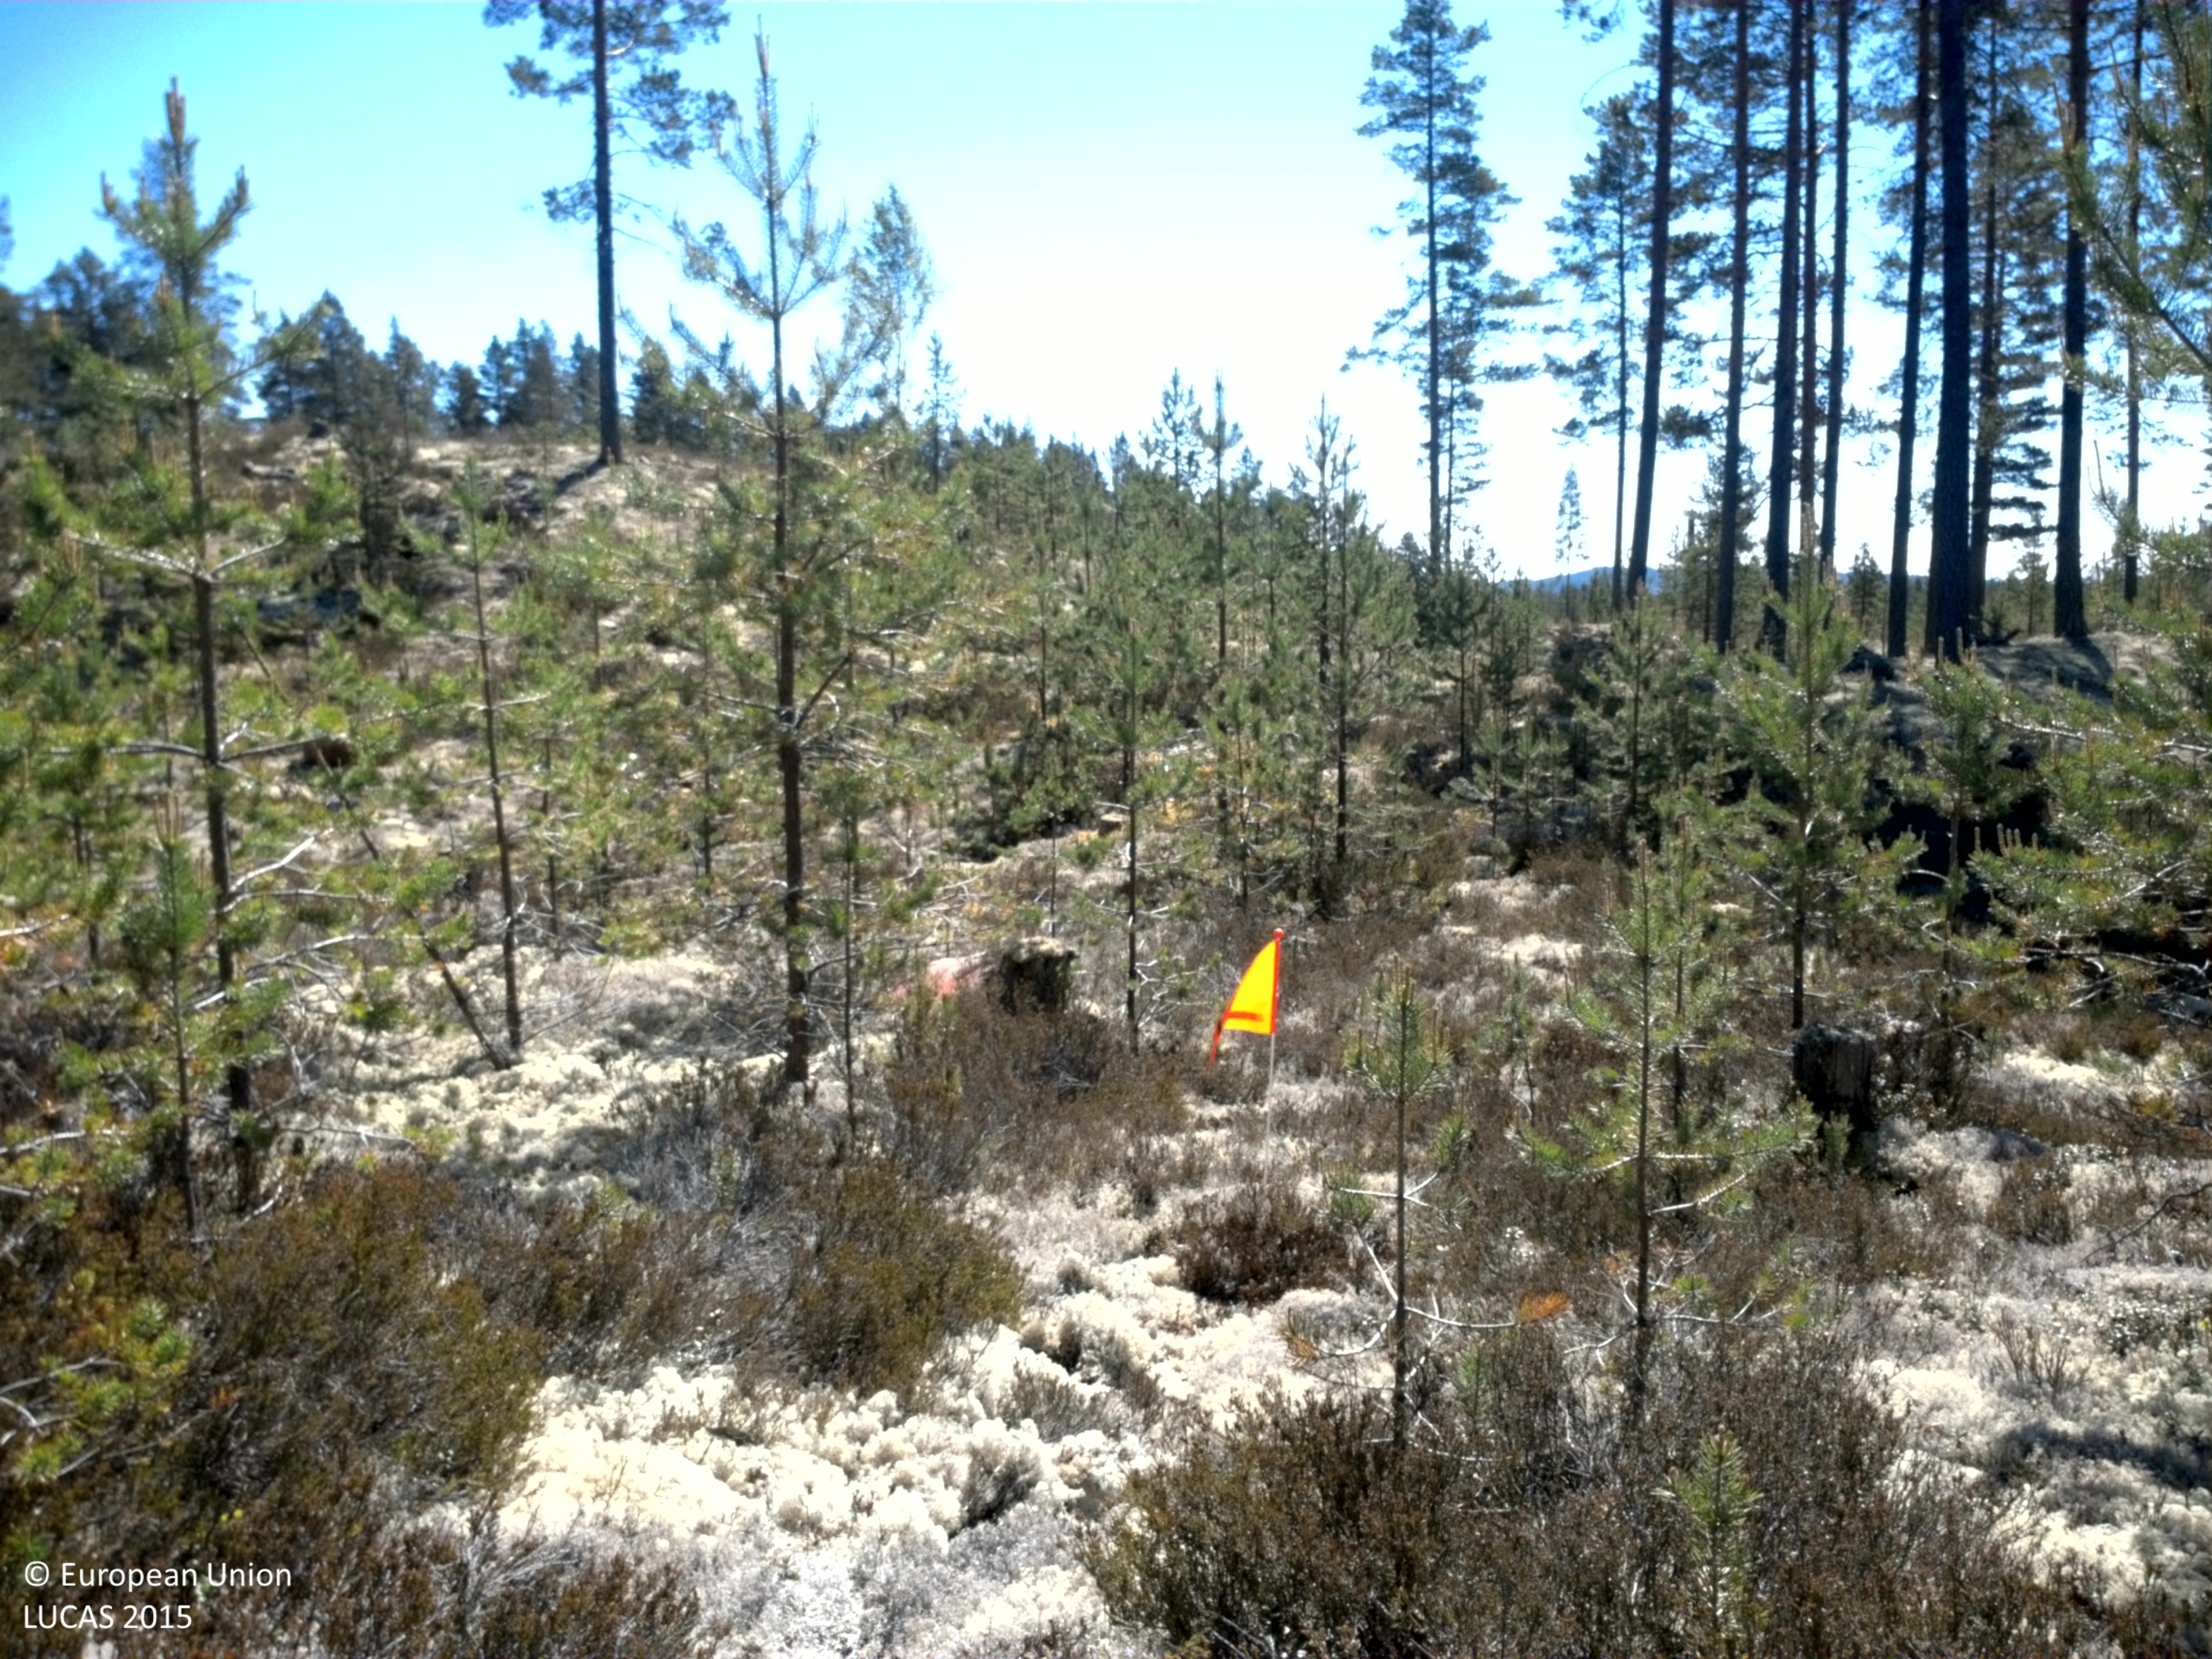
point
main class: Woodland
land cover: Pine dominated coniferous woodland
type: boreal forest
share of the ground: 25 - 50 %
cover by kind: coniferous forest trees 45 %, lichens and mosses 25 %, shrubs 15 %, consolidated bare surface 10 %, herbaceous plants 5 %
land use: Forestry
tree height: < 5 m
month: June
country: SE
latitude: 61.3597
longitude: 13.6343
